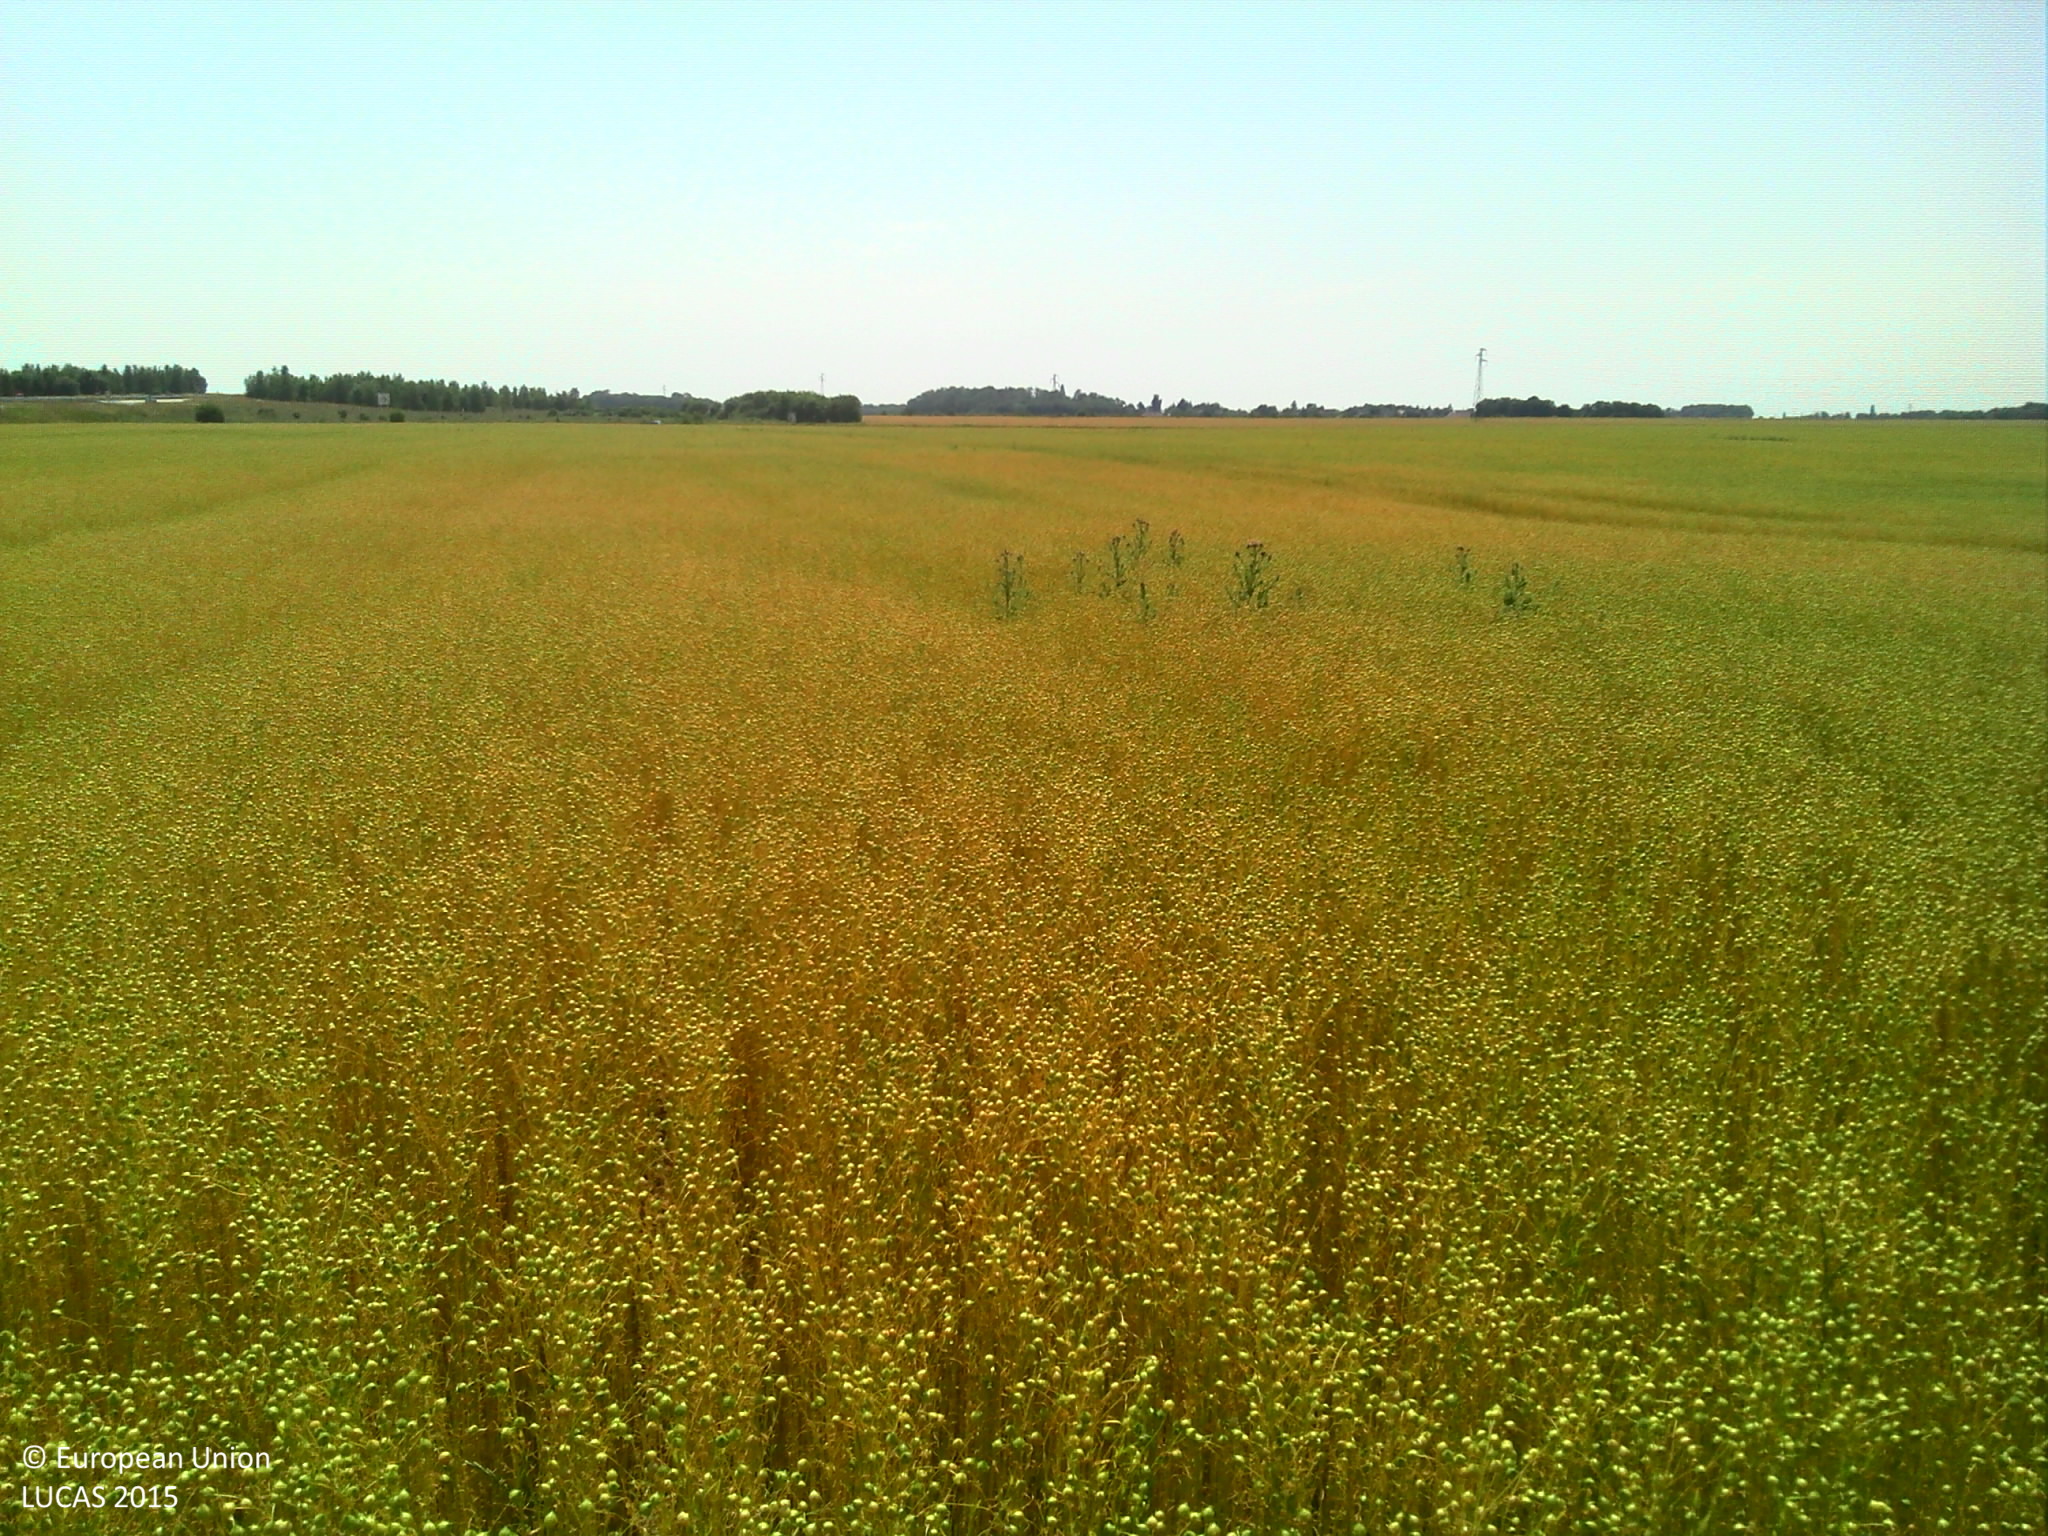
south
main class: Cropland
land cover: Other fibre and oleaginous crops
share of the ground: > 75 %
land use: Agriculture (excluding fallow land and kitchen gardens)
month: July
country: FR
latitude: 48.9568
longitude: 1.1986
